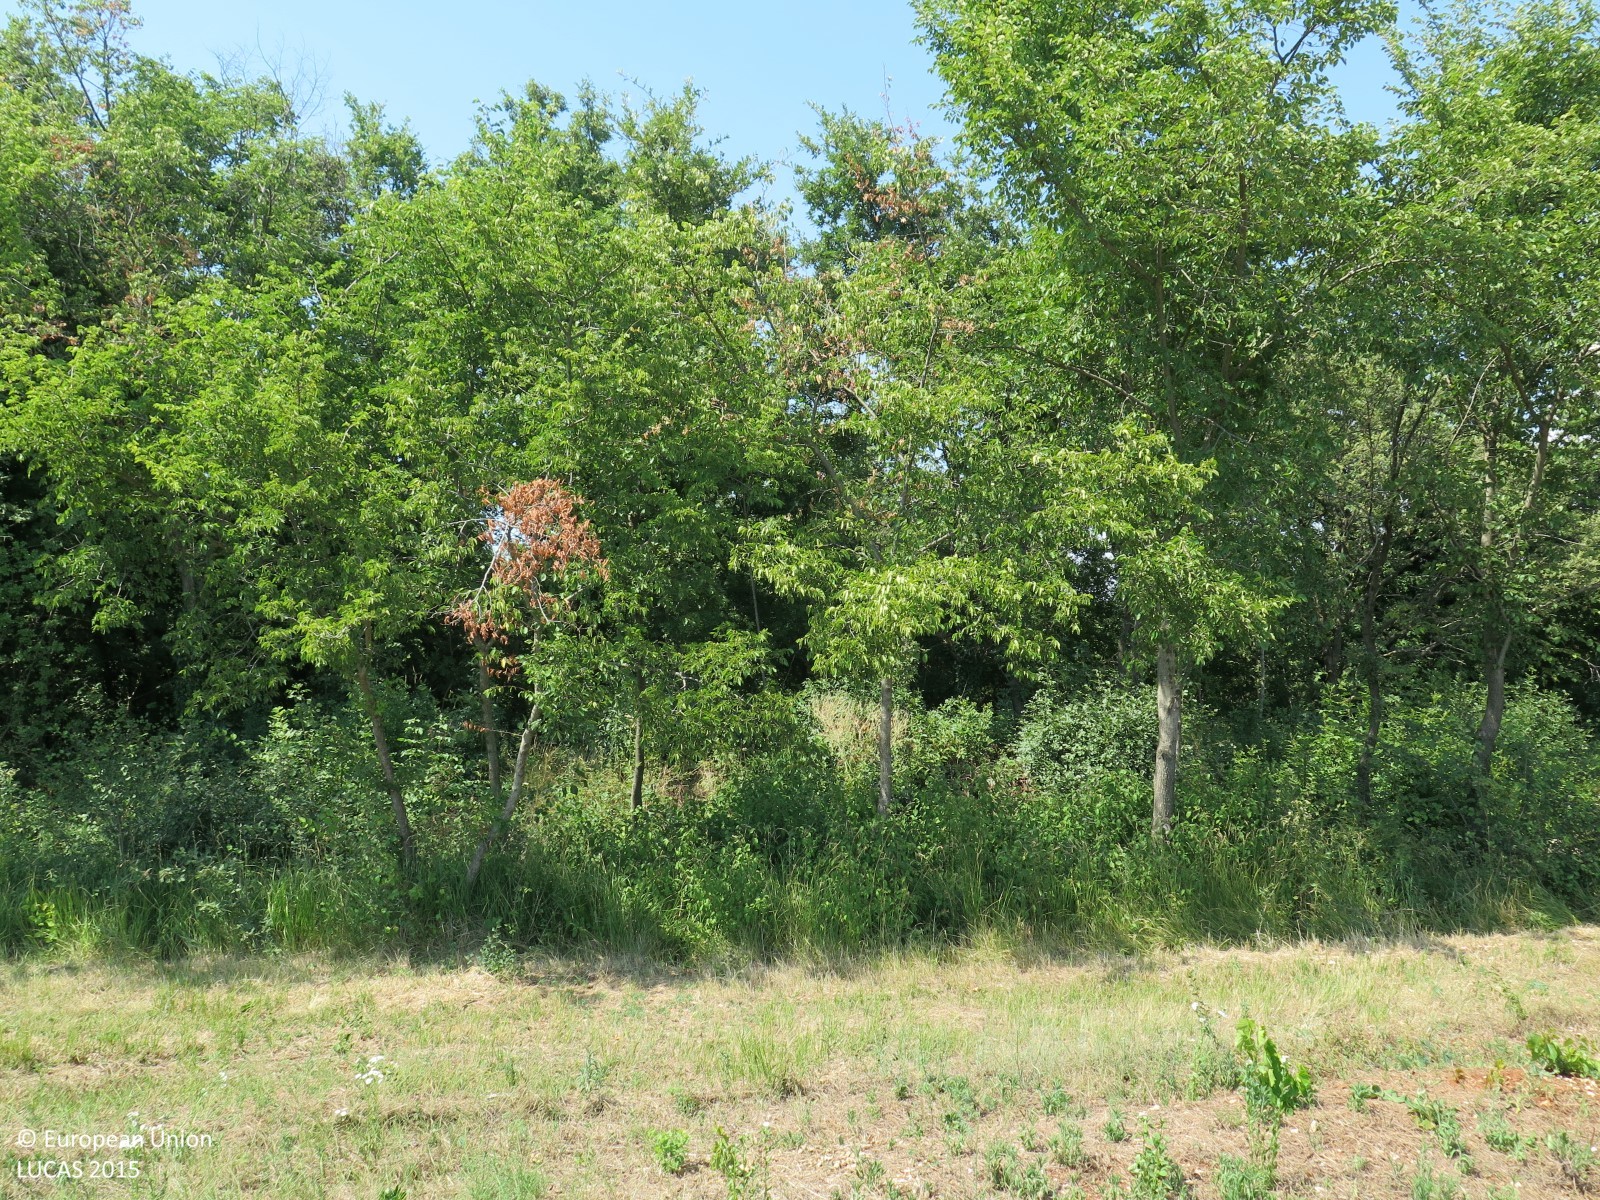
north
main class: Grassland
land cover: Grassland without tree/shrub cover
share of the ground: > 75 %
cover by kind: herbaceous plants 100 %
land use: Abandoned areas
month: July
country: HR
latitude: 45.1654
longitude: 13.7987
